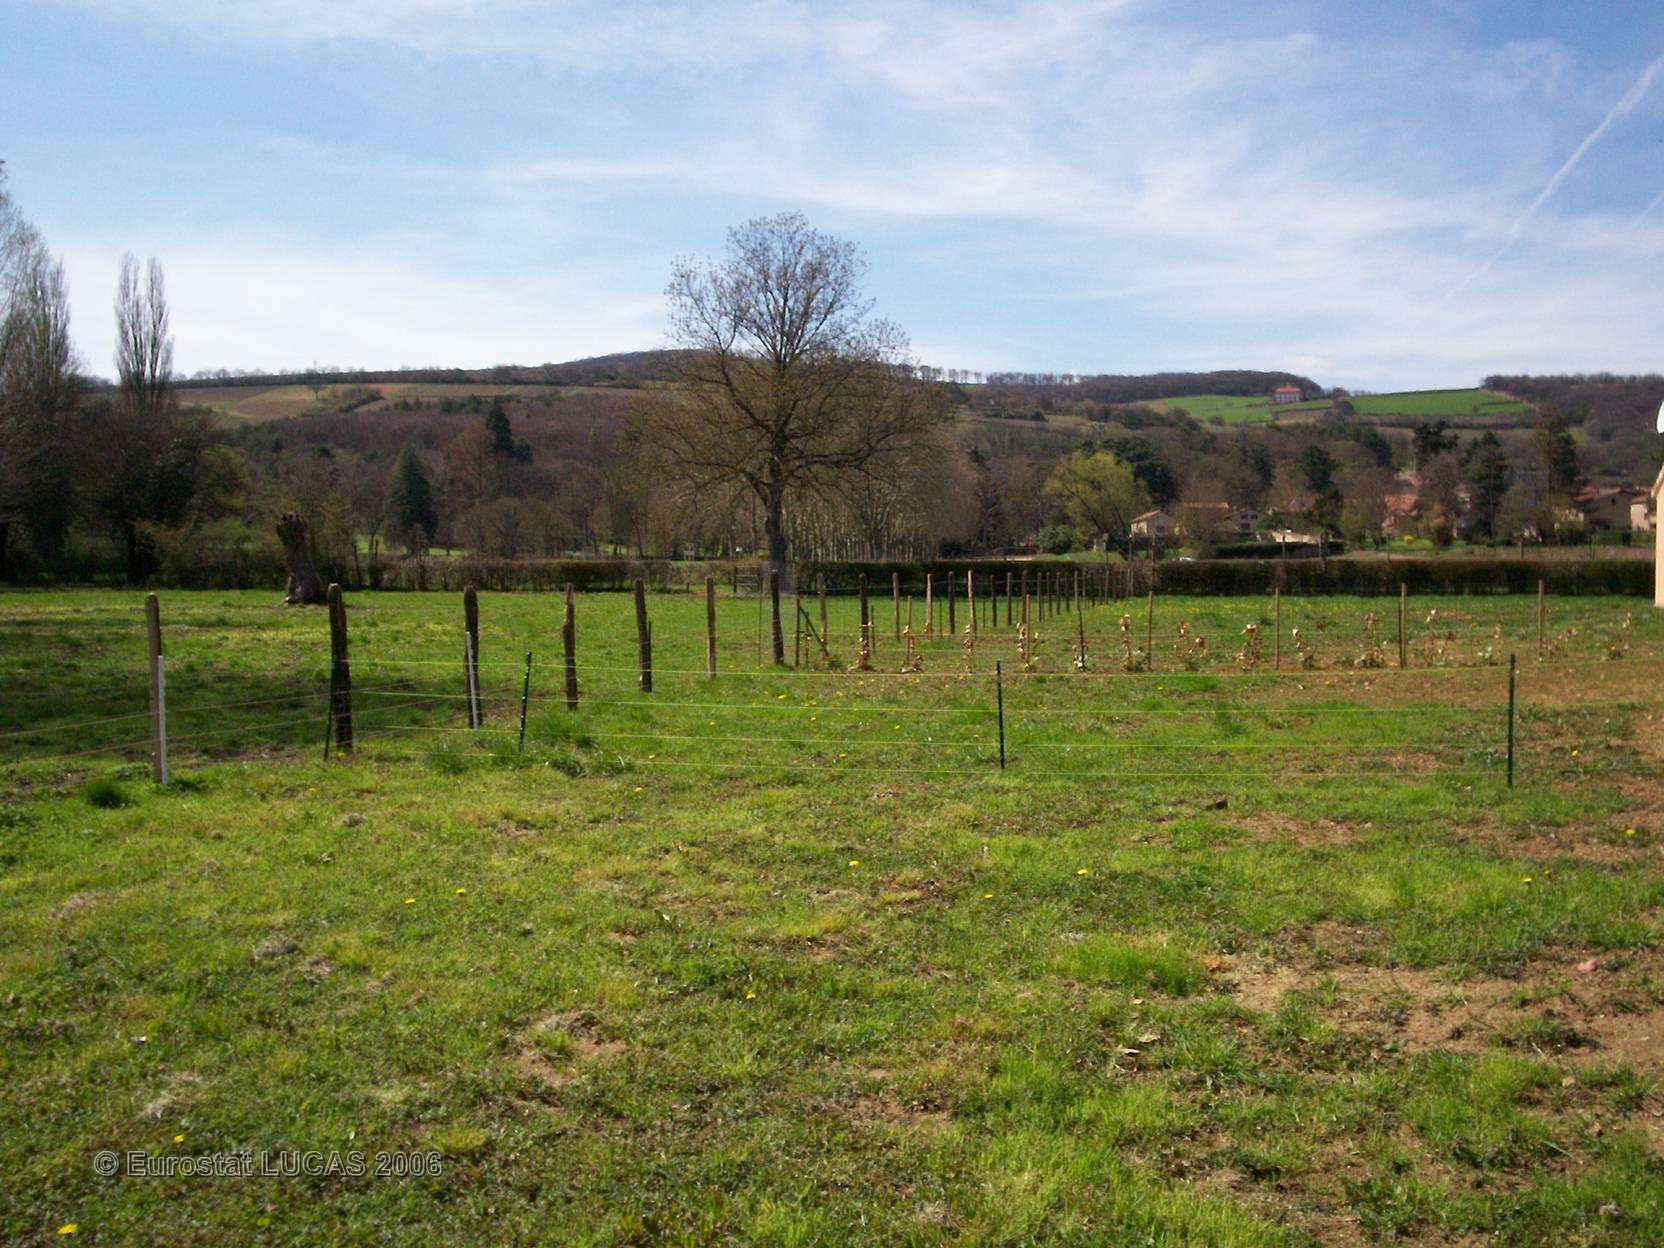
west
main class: Grassland
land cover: Grassland without tree/shrub cover
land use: Residential
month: April
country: FR
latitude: 46.4212
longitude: 4.7583
